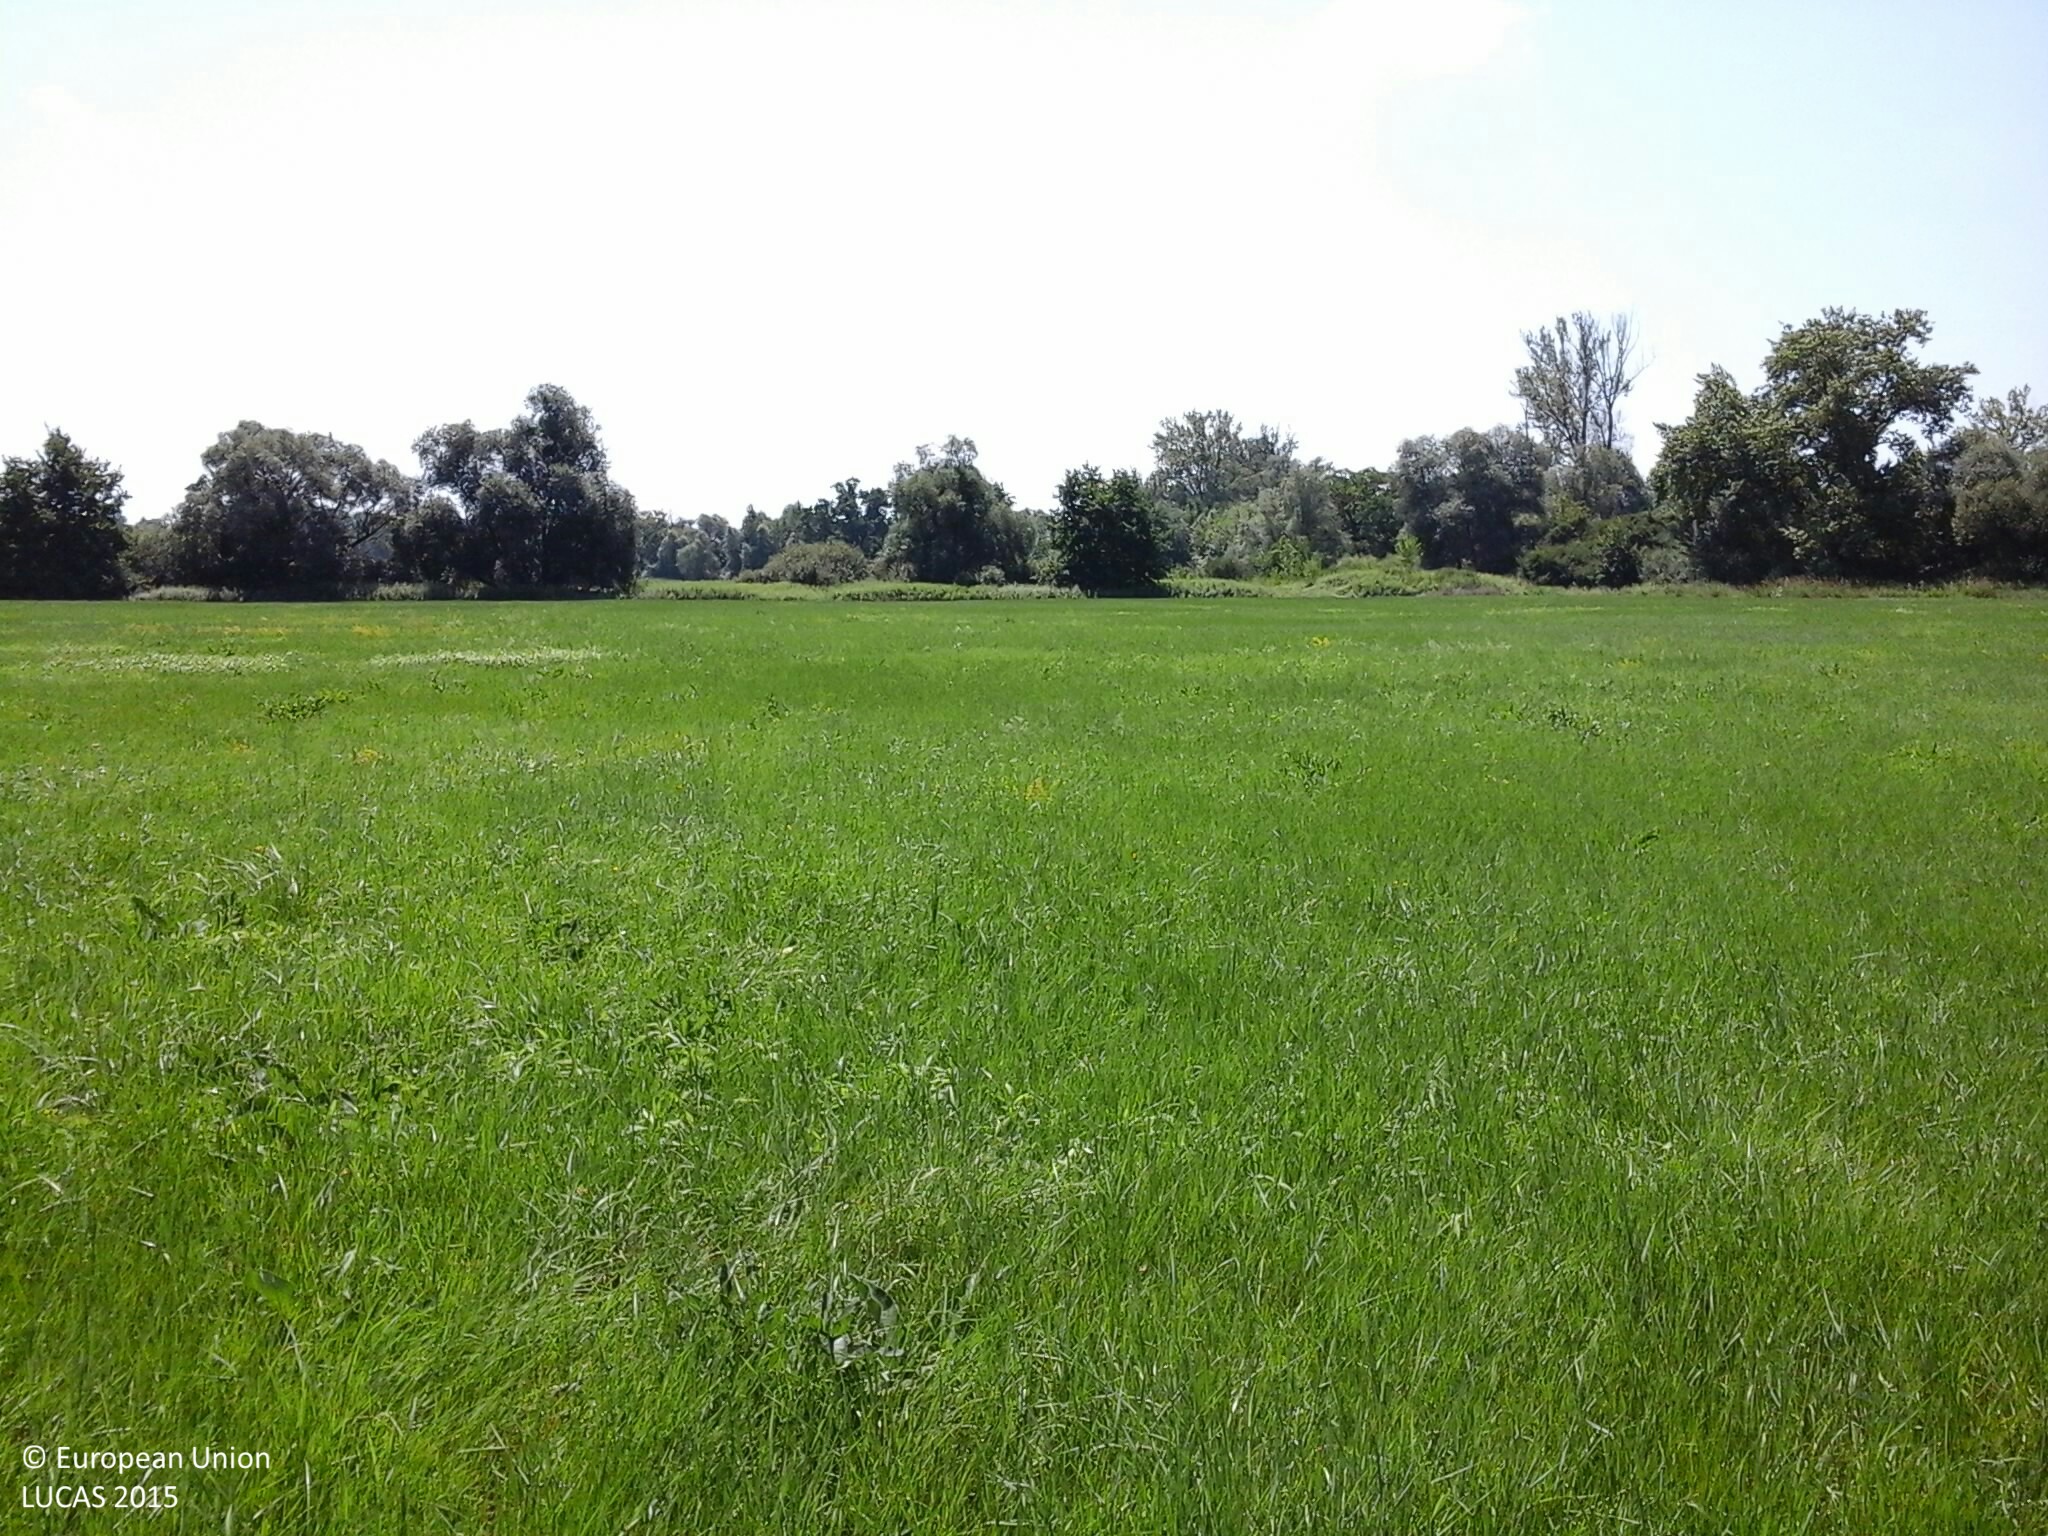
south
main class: Grassland
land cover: Grassland without tree/shrub cover
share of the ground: > 75 %
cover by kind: herbaceous plants 100 %
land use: Agriculture (excluding fallow land and kitchen gardens)
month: July
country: HU
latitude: 46.9969
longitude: 16.5911
